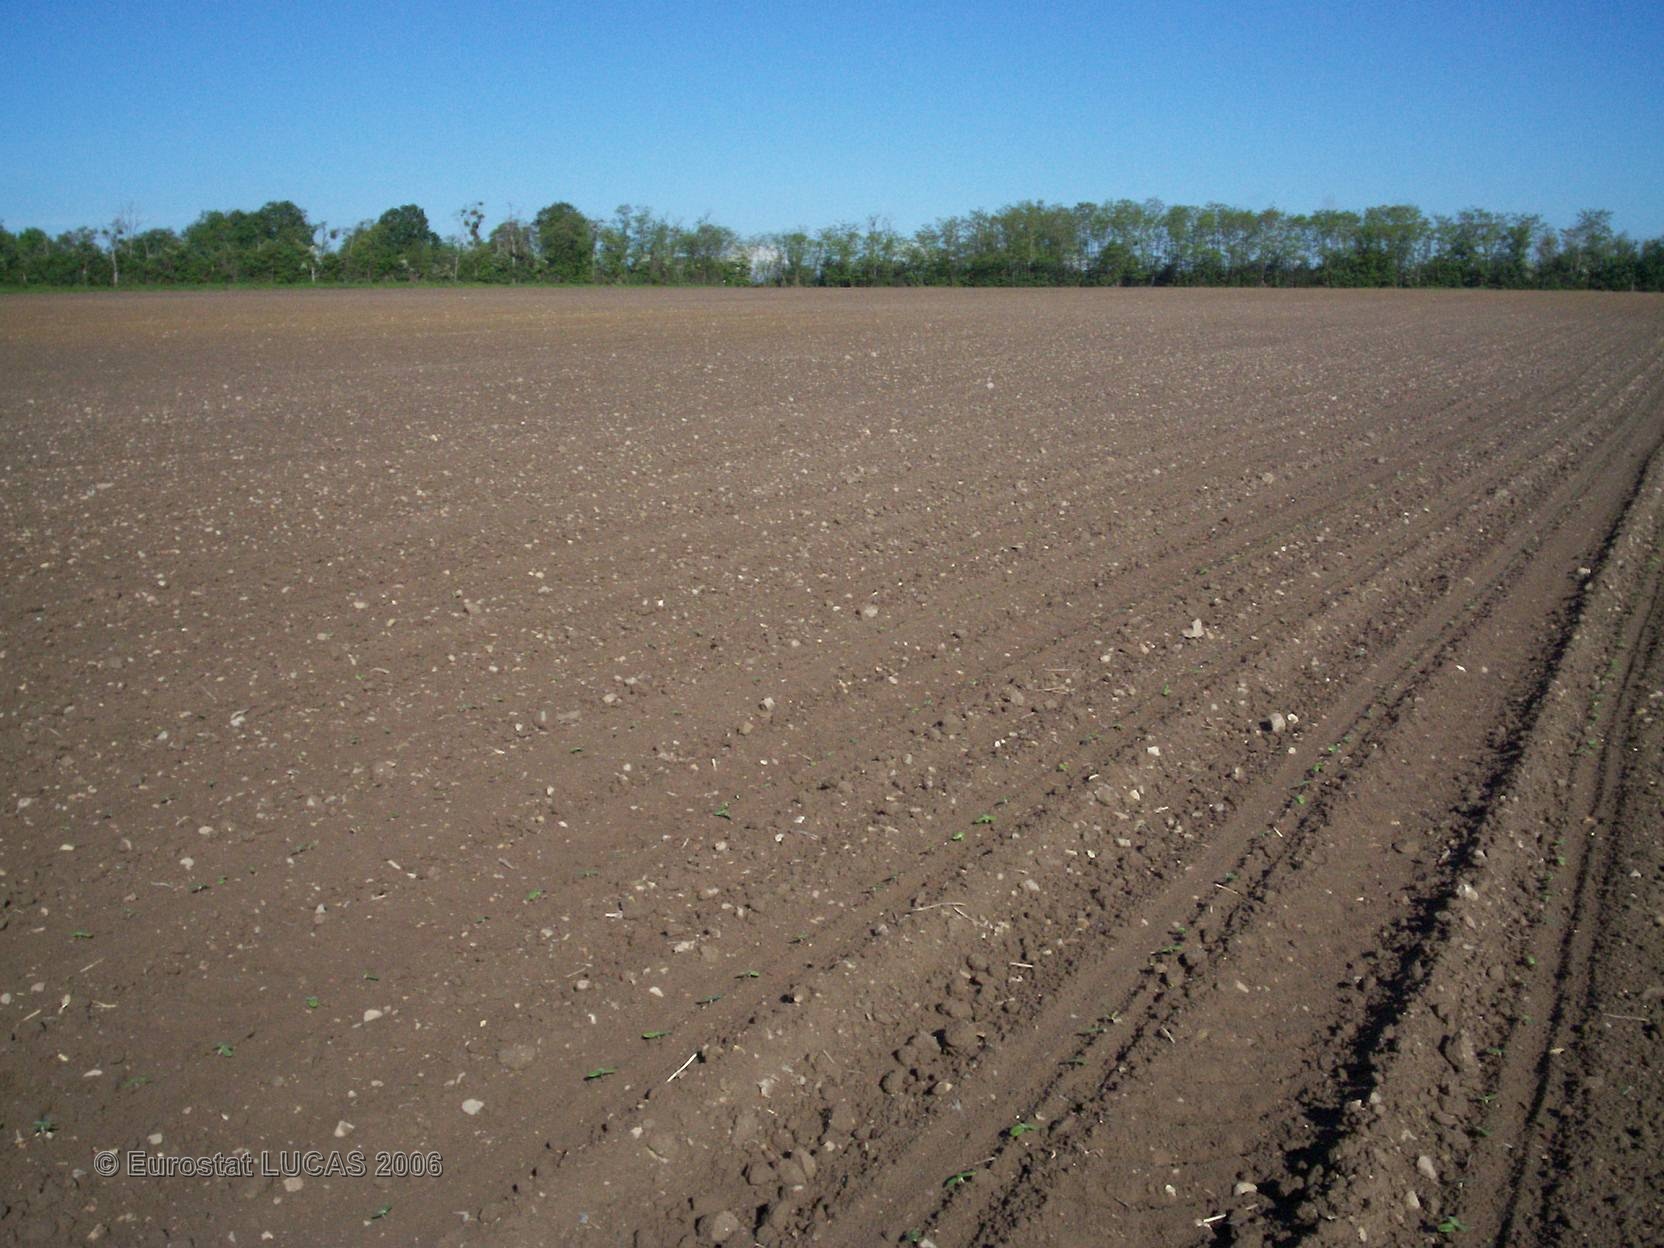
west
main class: Cropland
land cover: Sunflower
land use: Agriculture (excluding fallow land and kitchen gardens)
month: May
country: FR
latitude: 46.2672
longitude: 0.4465
